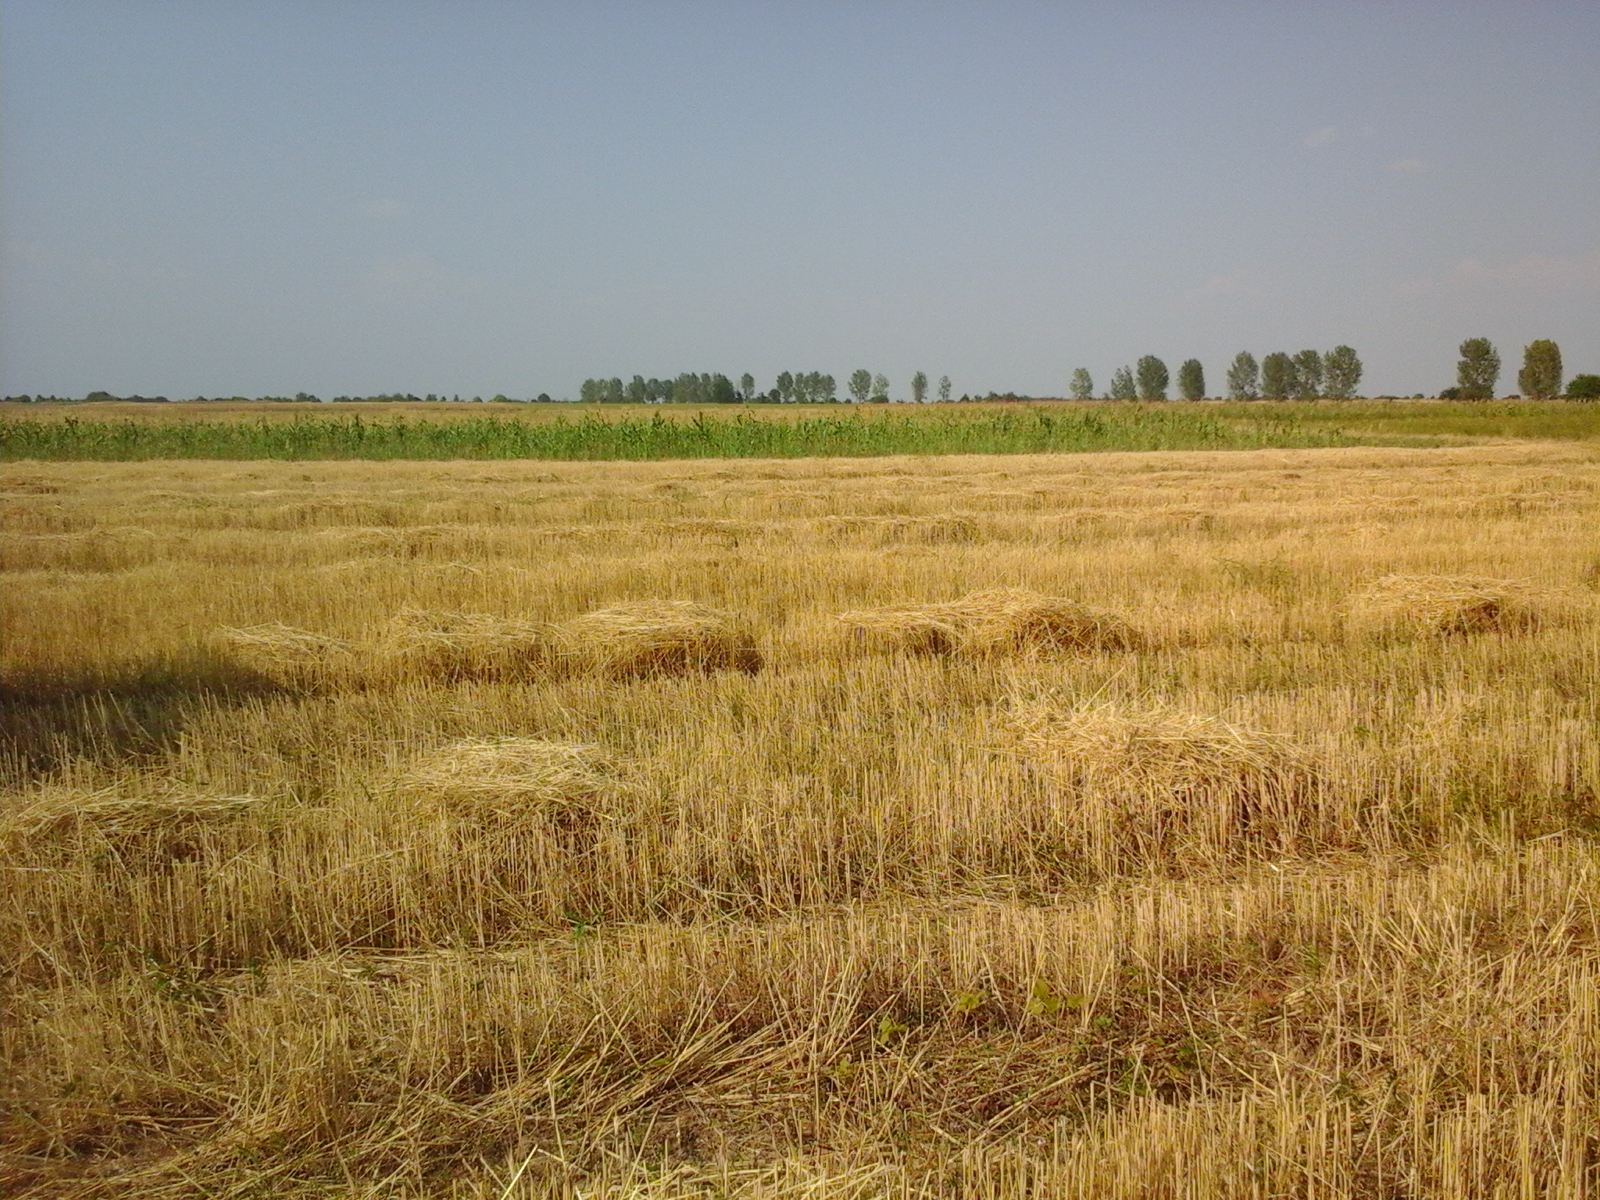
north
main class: Cropland
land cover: Barley
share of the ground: > 75 %
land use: Agriculture (excluding fallow land and kitchen gardens)
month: August
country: RO
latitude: 44.4759
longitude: 22.5732
